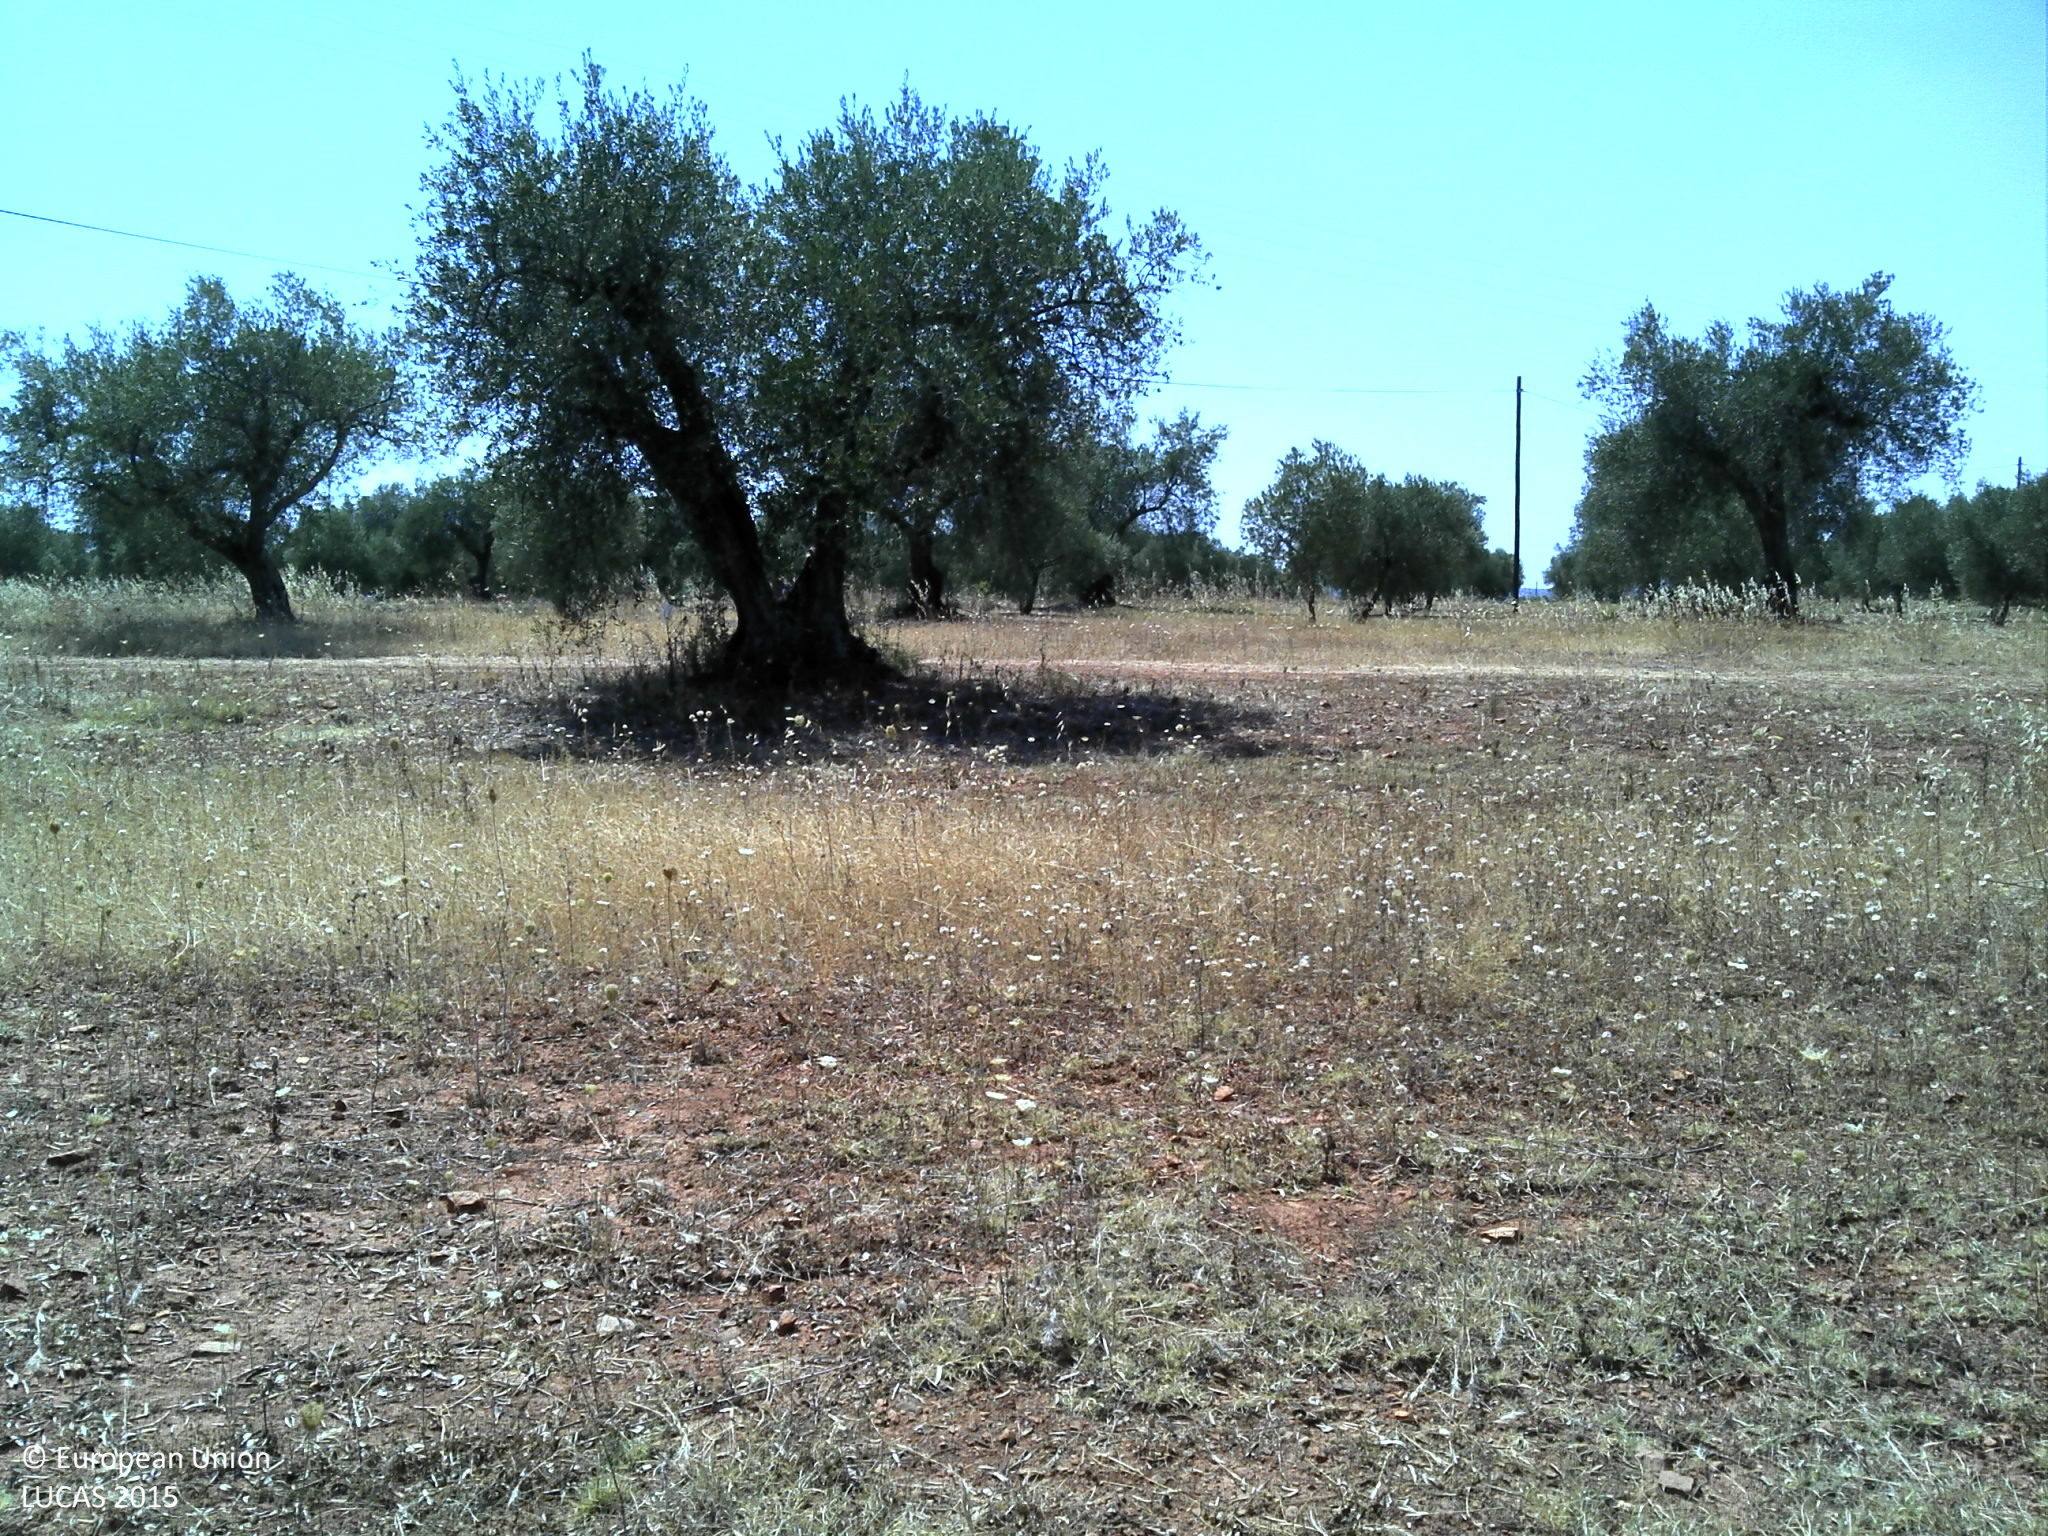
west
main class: Cropland
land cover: Olive groves
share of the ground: 25 - 50 %
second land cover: Grassland without tree/shrub cover
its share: 10 - 25 %
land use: Agriculture (excluding fallow land and kitchen gardens)
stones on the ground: < 10 %
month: June
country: PT
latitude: 38.0553
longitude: -7.5841
